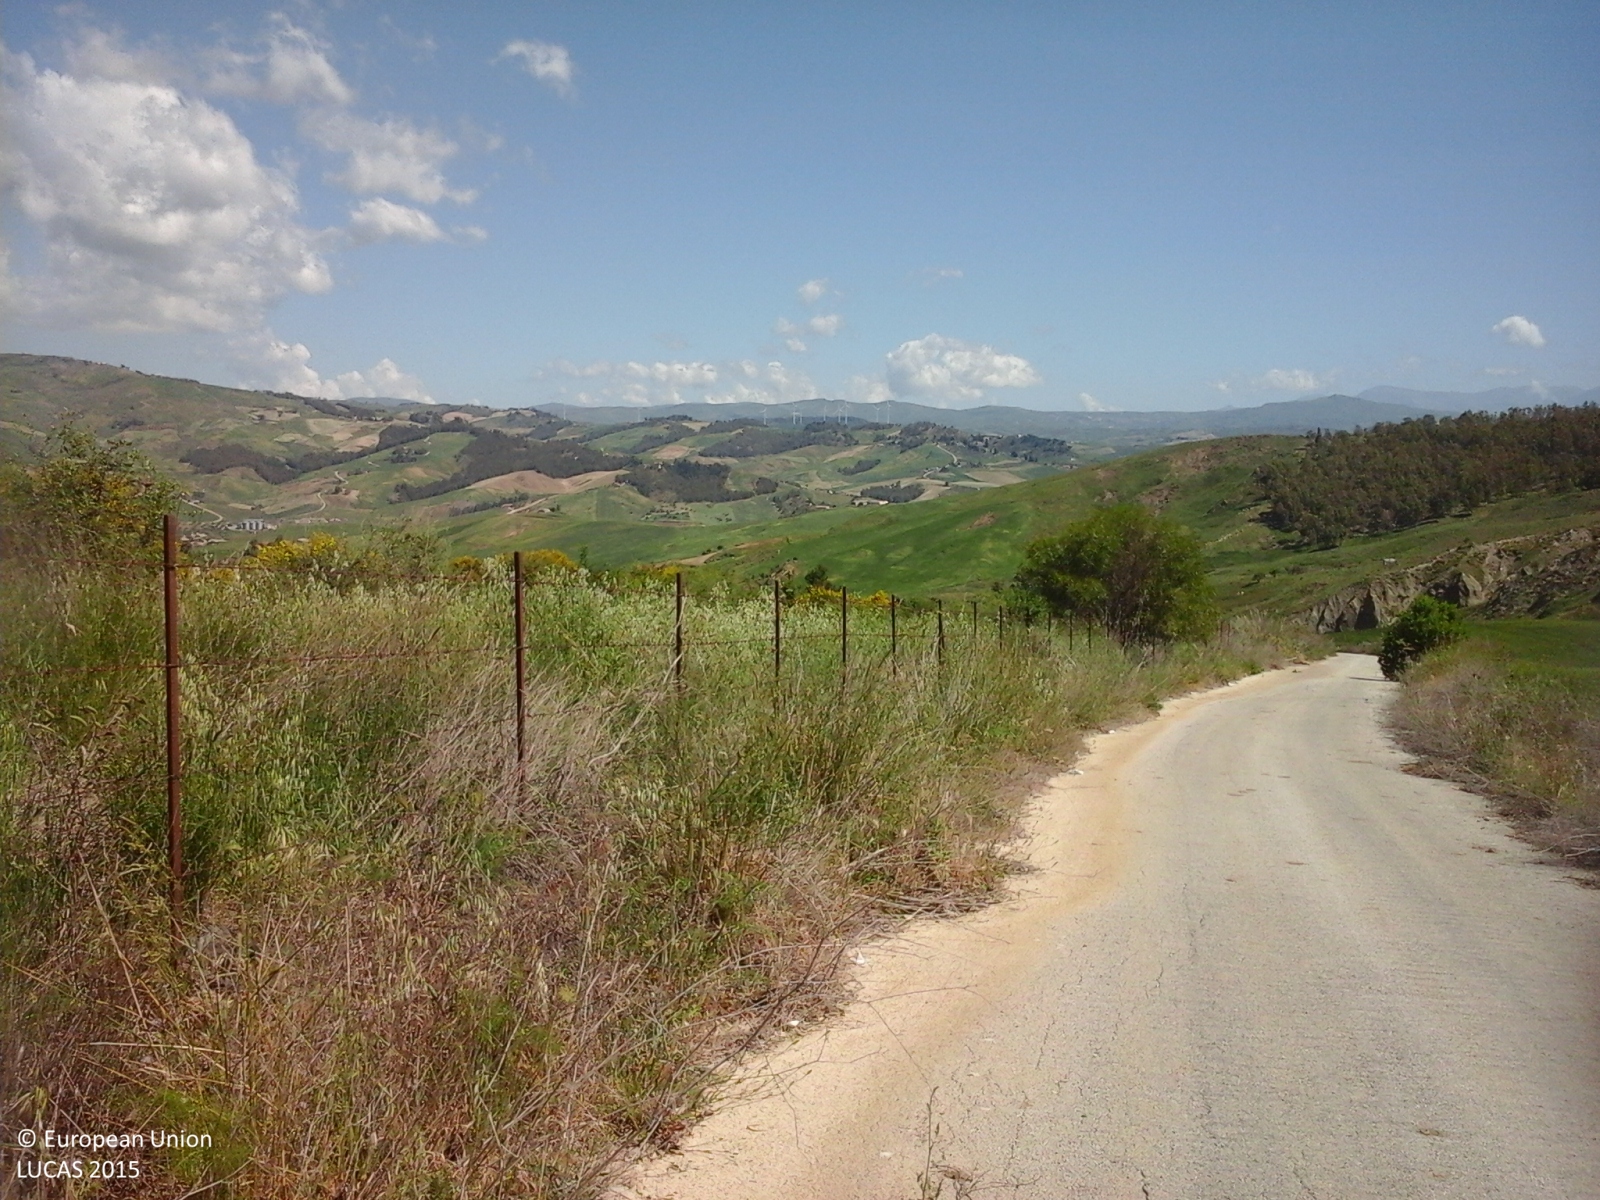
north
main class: Grassland
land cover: Grassland with sparse tree/shrub cover
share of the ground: > 75 %
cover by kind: herbaceous plants 90 %, coniferous forest trees 5 %, shrubs 5 %
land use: Agriculture (excluding fallow land and kitchen gardens)
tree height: < 5 m
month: May
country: IT
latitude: 37.6011
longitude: 13.7440
